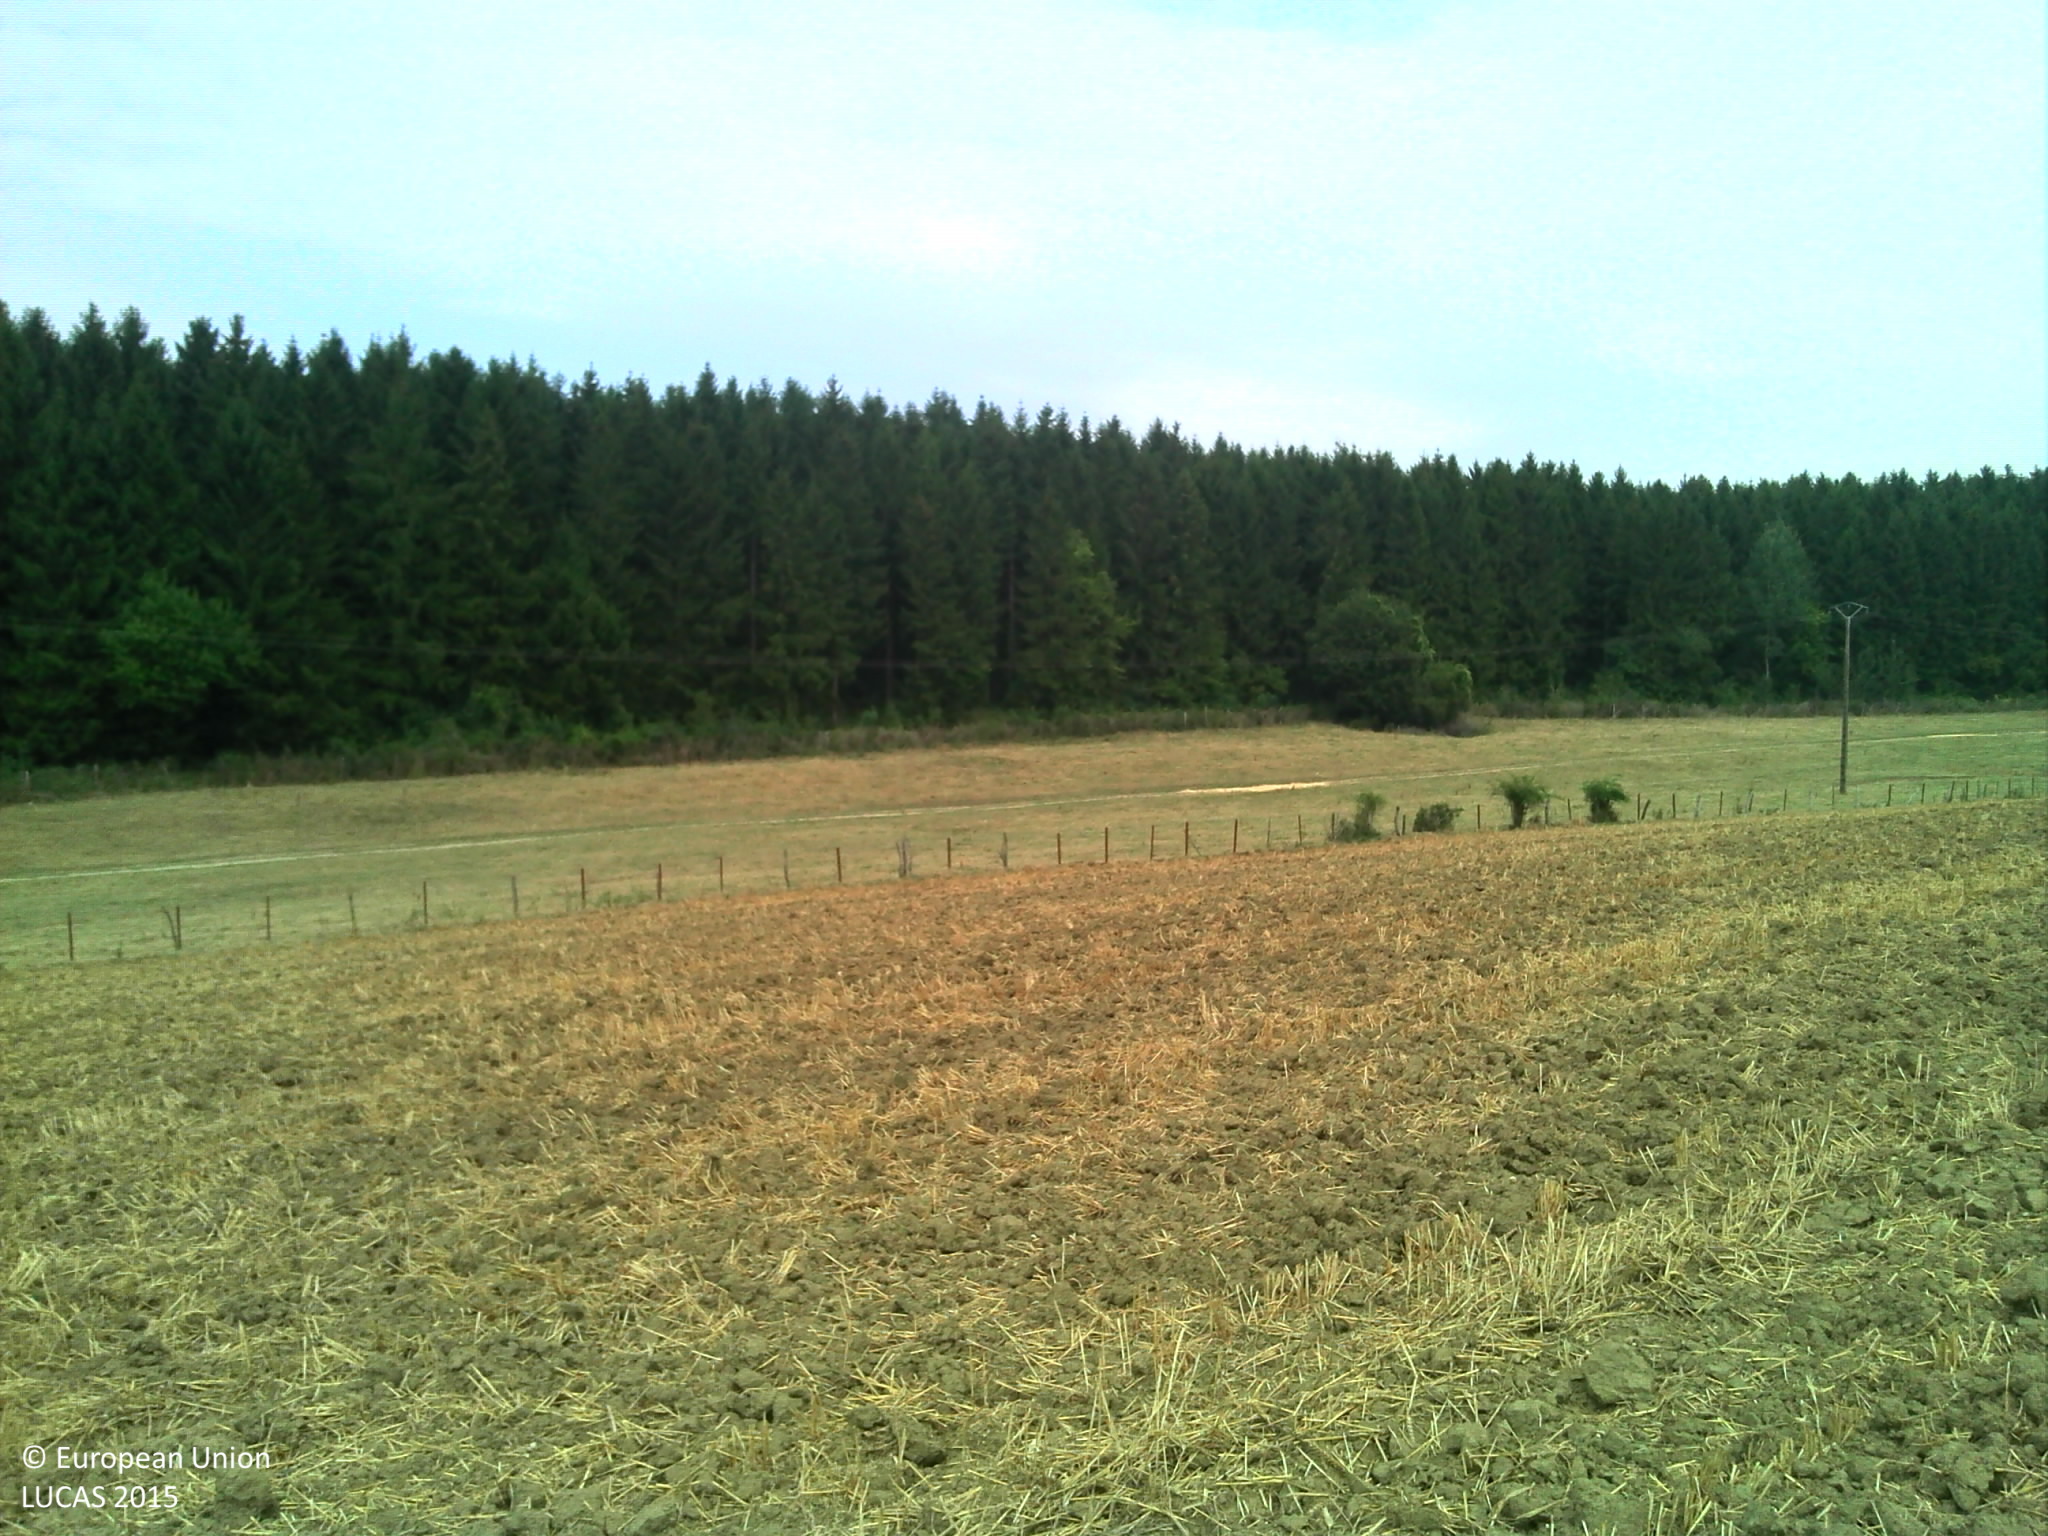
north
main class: Cropland
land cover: Common wheat
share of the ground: < 10 %
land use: Agriculture (excluding fallow land and kitchen gardens)
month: August
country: FR
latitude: 49.3371
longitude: 5.0295
